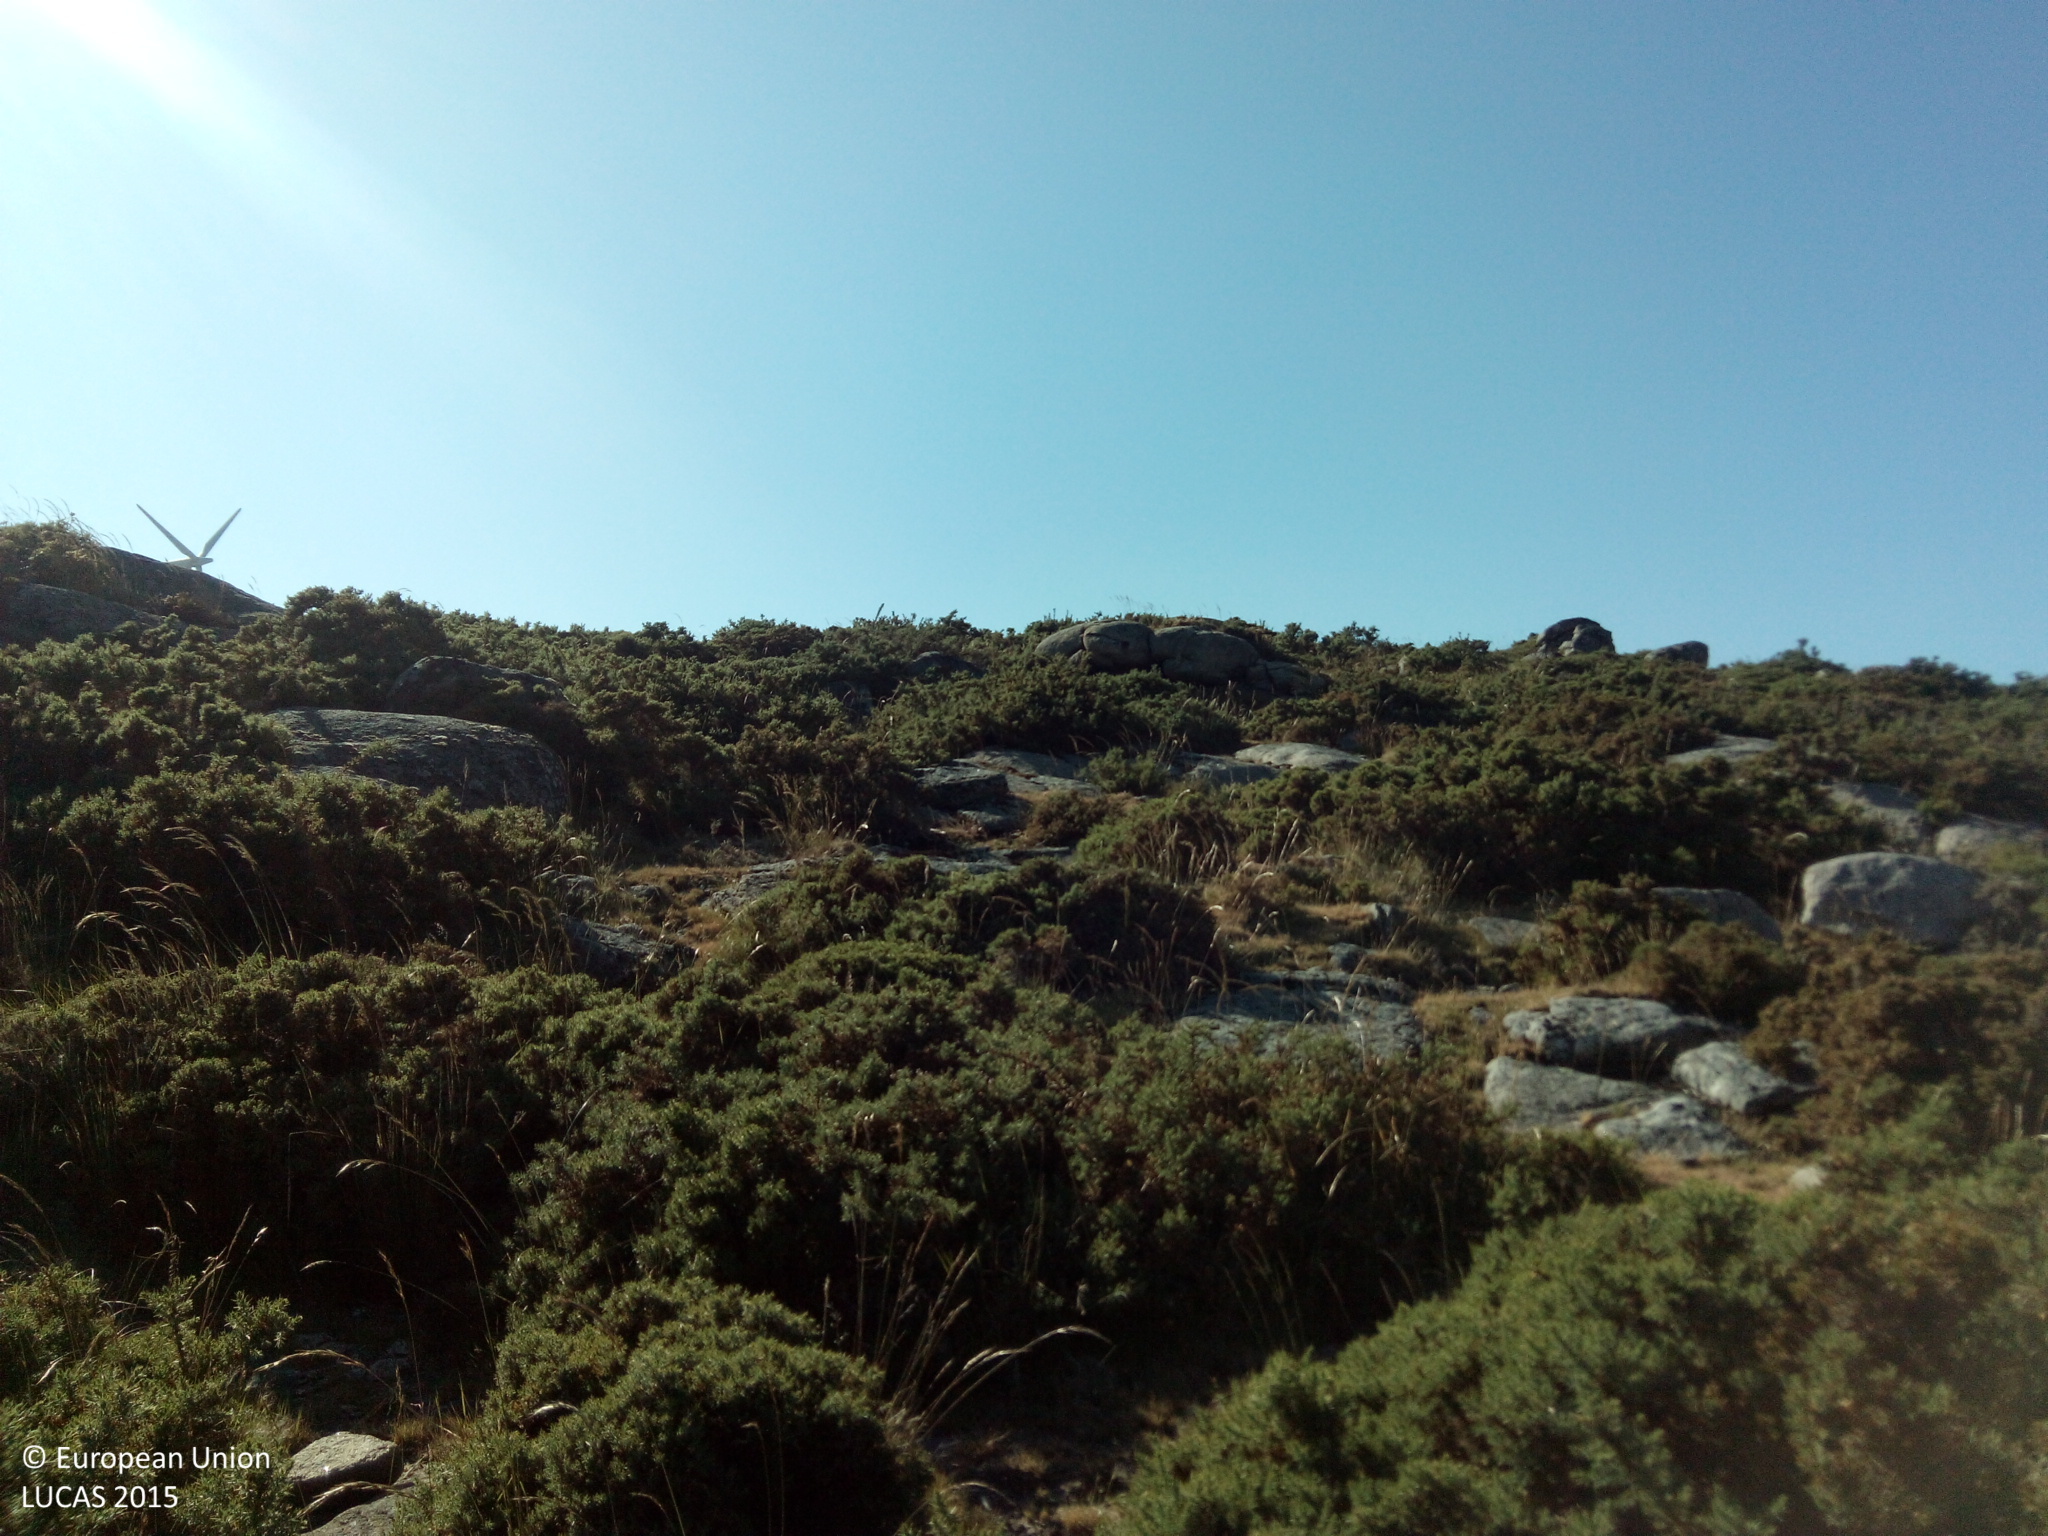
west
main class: Shrubland
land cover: Shrubland without tree cover
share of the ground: > 75 %
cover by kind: shrubs 100 %
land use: Semi-natural and natural areas not in use
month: June
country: ES
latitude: 42.3310
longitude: -8.3309
